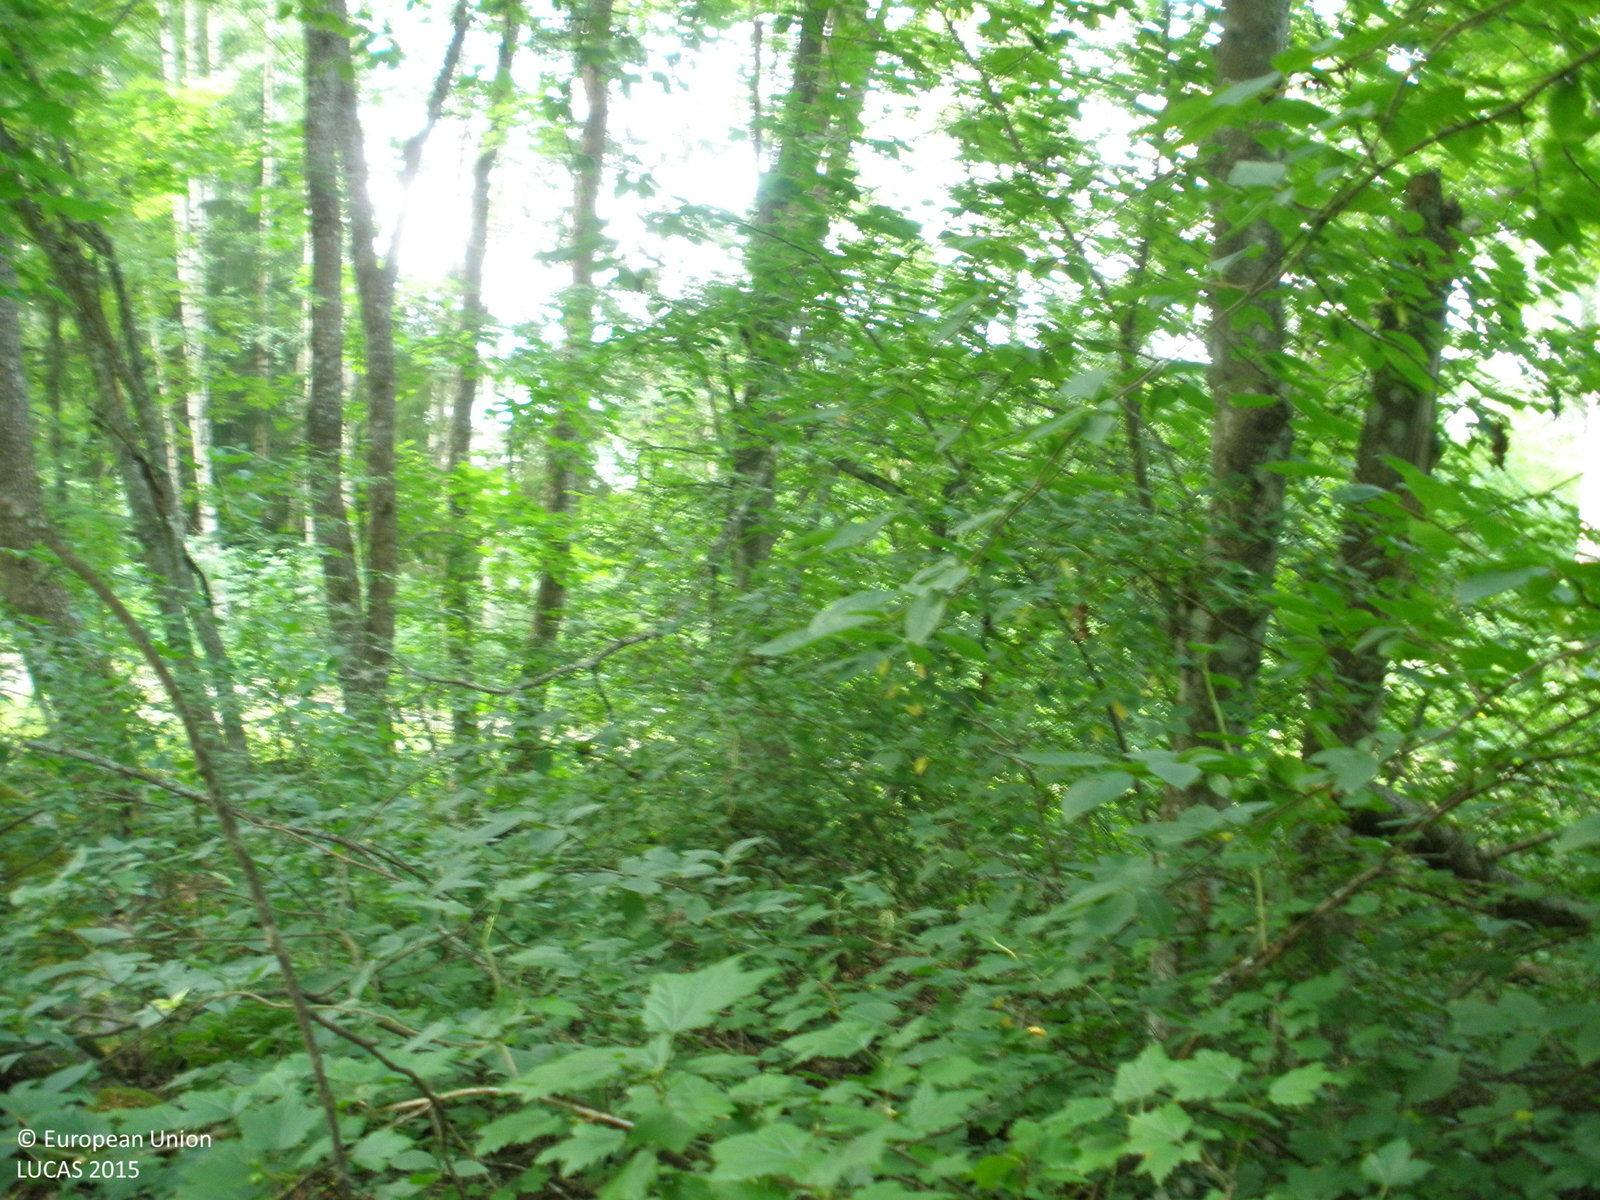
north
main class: Woodland
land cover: Broadleaved woodland
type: non-riverine alder, birch or aspen forest
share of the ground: > 75 %
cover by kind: broadleaved forest trees 85 %, herbaceous plants 10 %, shrubs 5 %
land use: Forestry
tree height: > 5 m
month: June
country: FI
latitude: 61.1718
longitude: 24.6616
